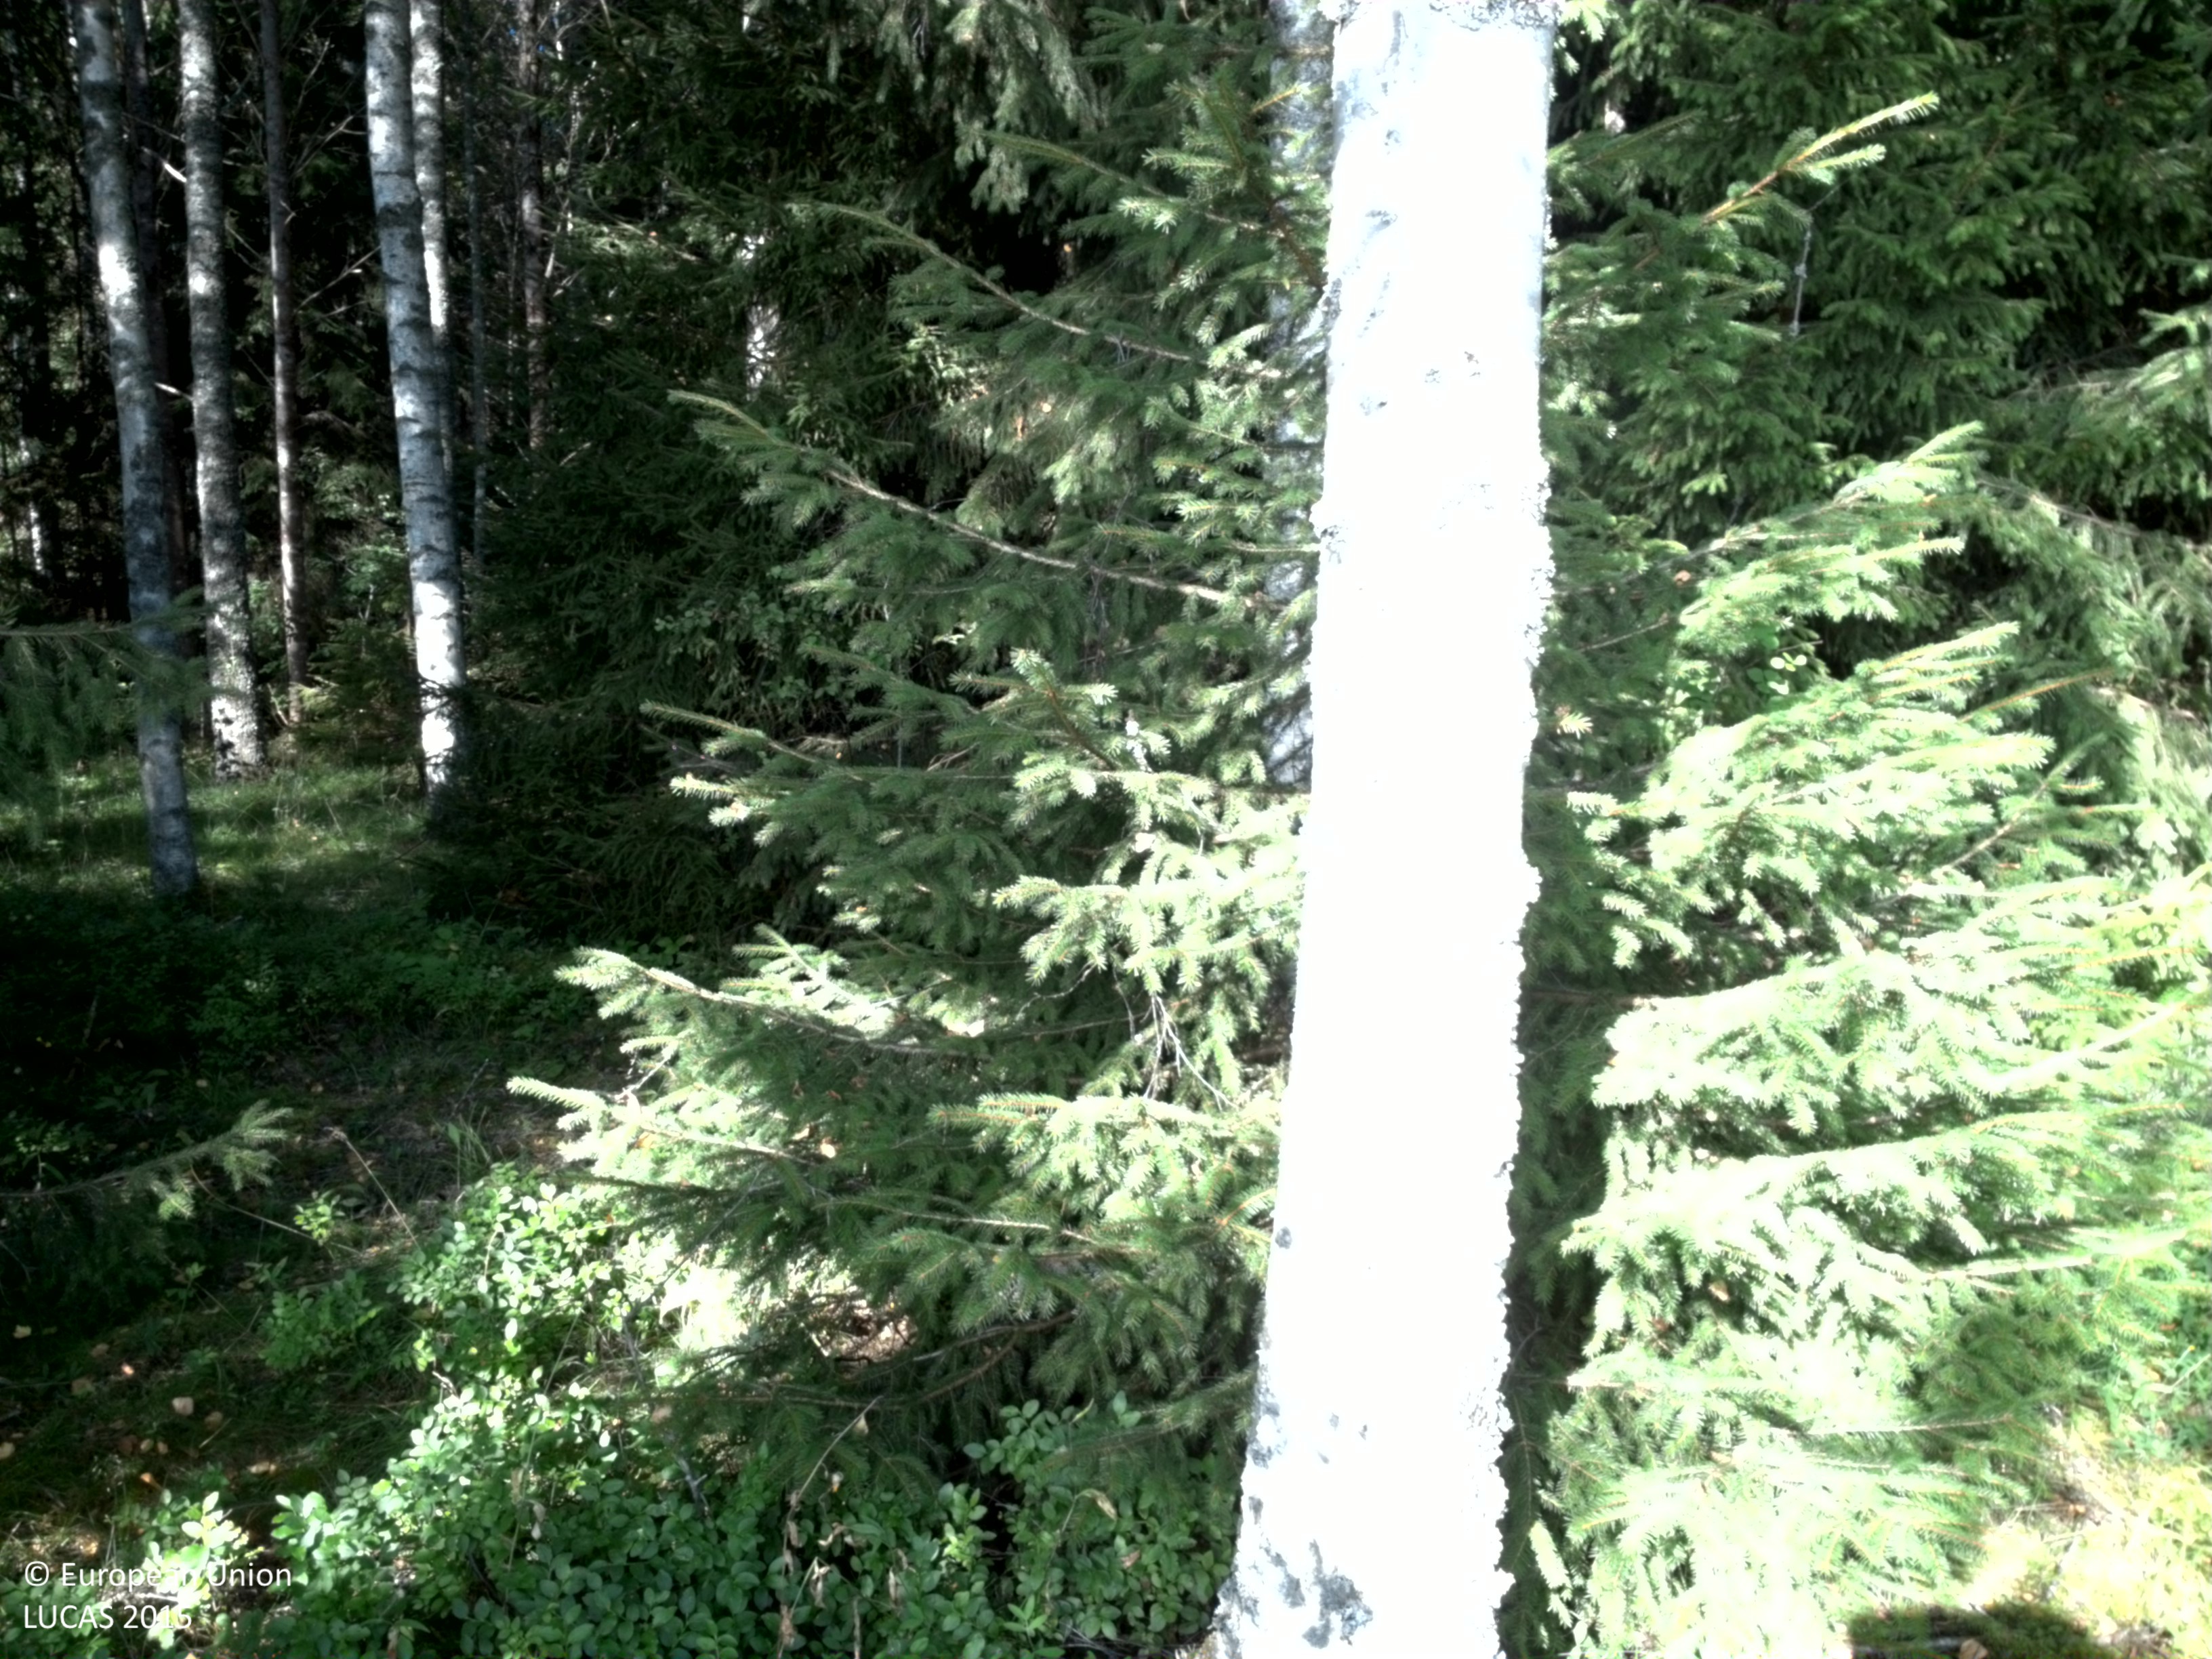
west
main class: Woodland
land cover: Spruce dominated mixed woodland
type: boreal forest
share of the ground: > 75 %
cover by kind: coniferous forest trees 60 %, broadleaved forest trees 20 %, herbaceous plants 20 %
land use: Forestry
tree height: > 5 m
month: August
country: SE
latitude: 59.9172
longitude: 16.9852
